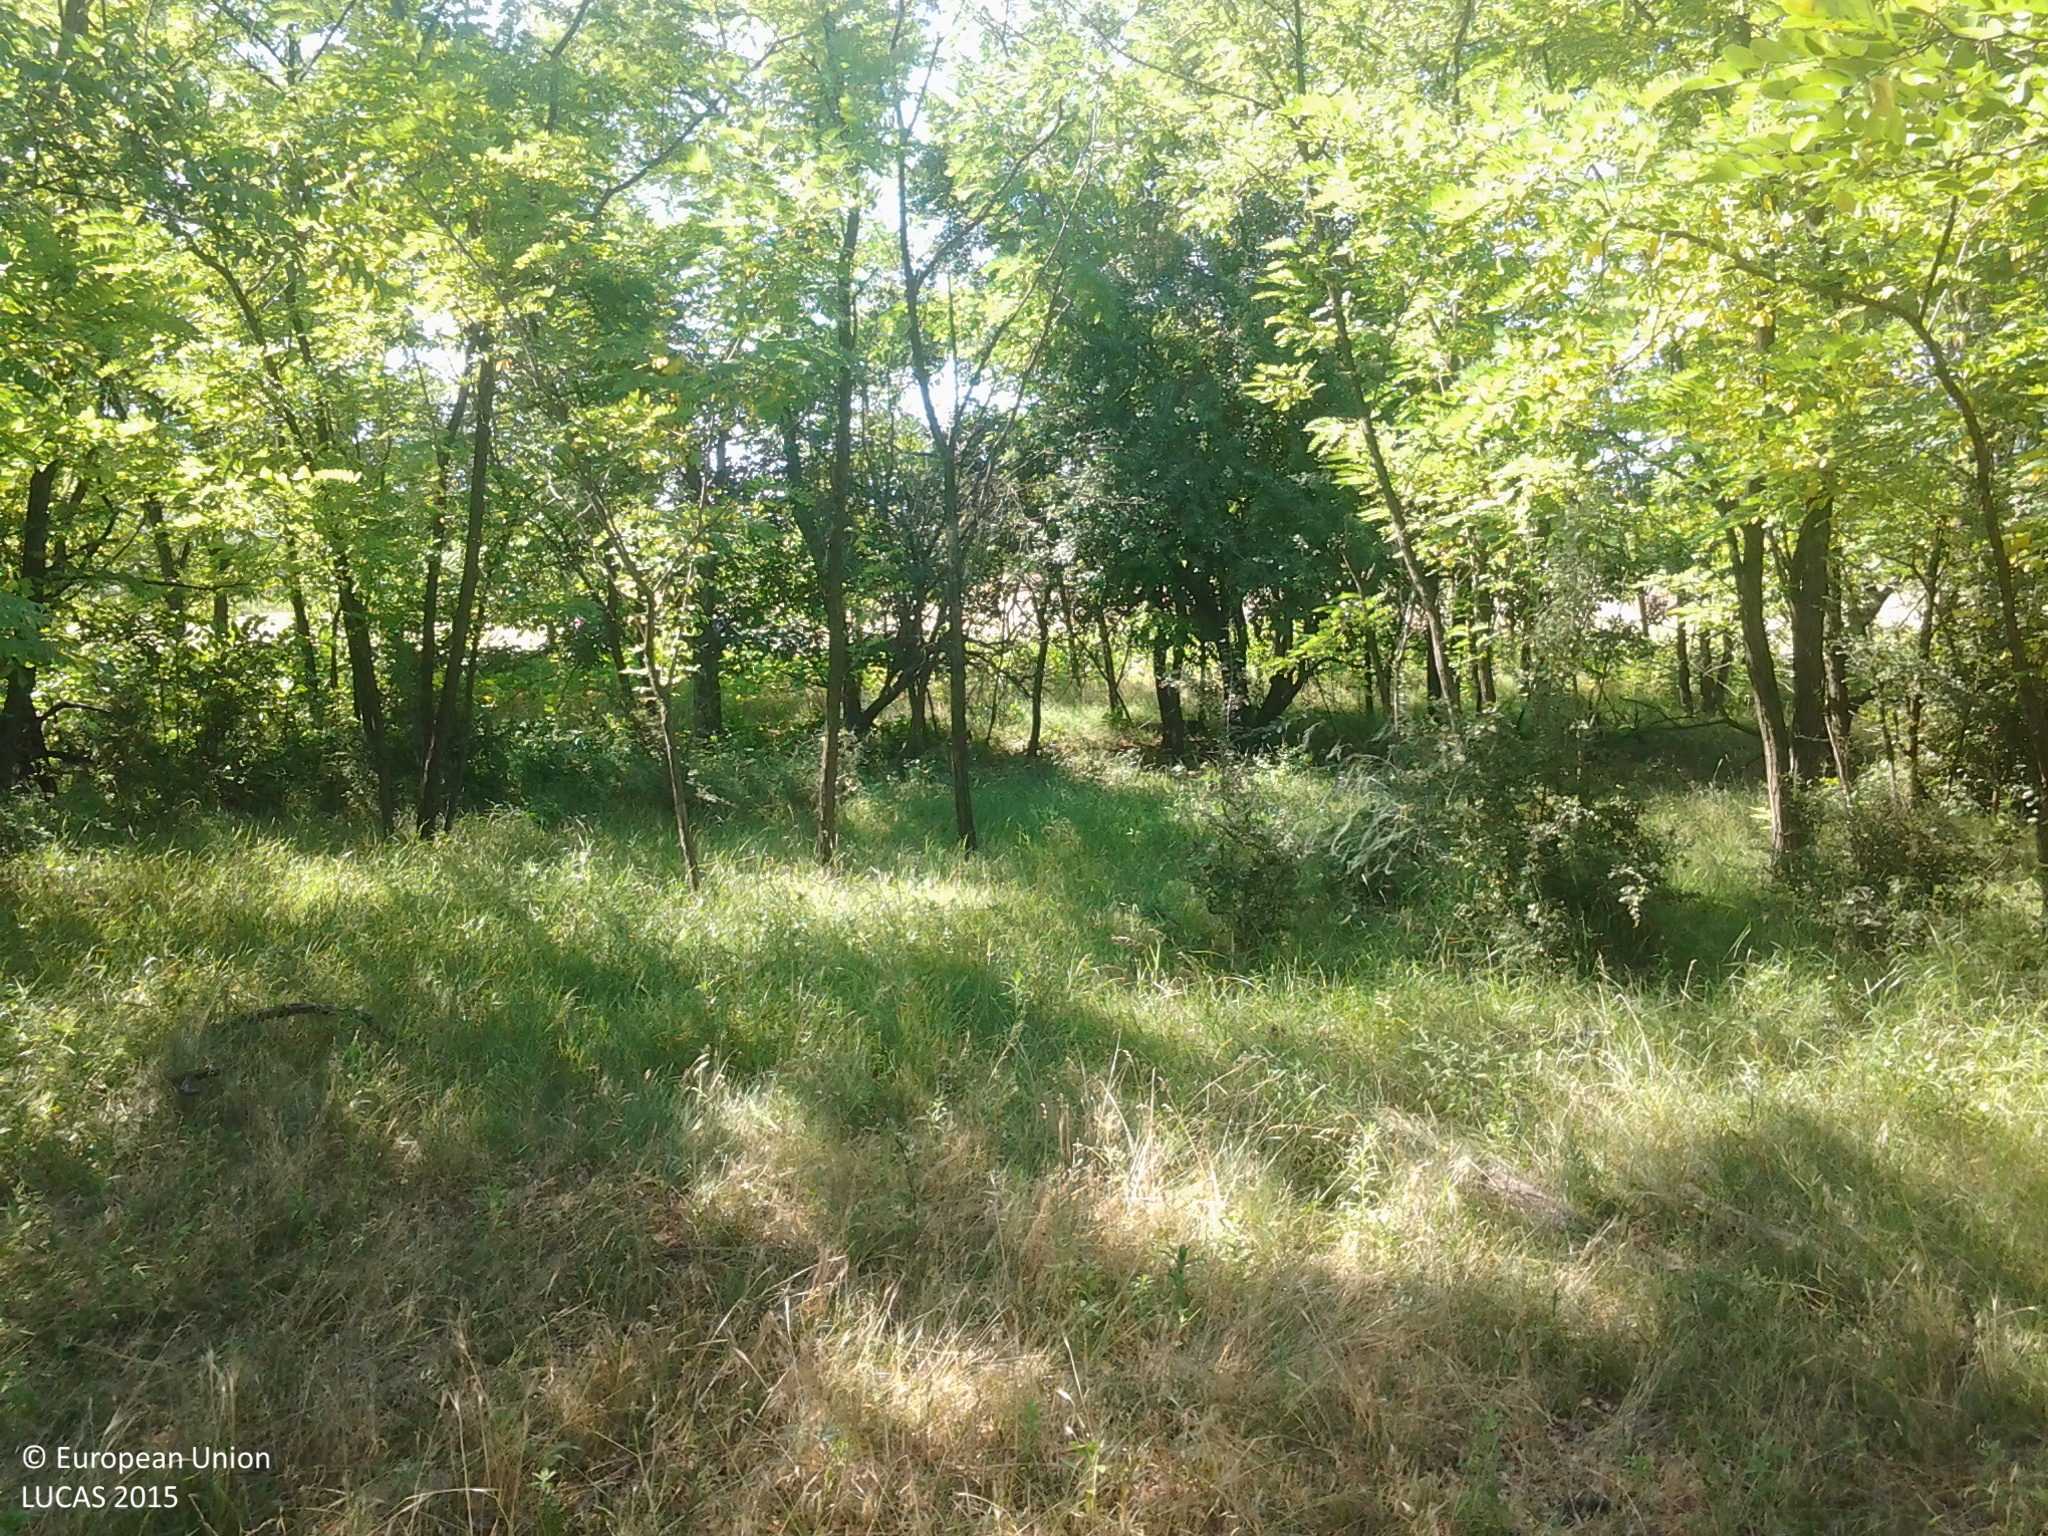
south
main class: Woodland
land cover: Broadleaved woodland
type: exotic forest
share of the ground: 50 - 75 %
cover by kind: broadleaved forest trees 70 %, herbaceous plants 30 %
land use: Forestry
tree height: > 5 m
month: July
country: HU
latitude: 46.5395
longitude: 19.5500
